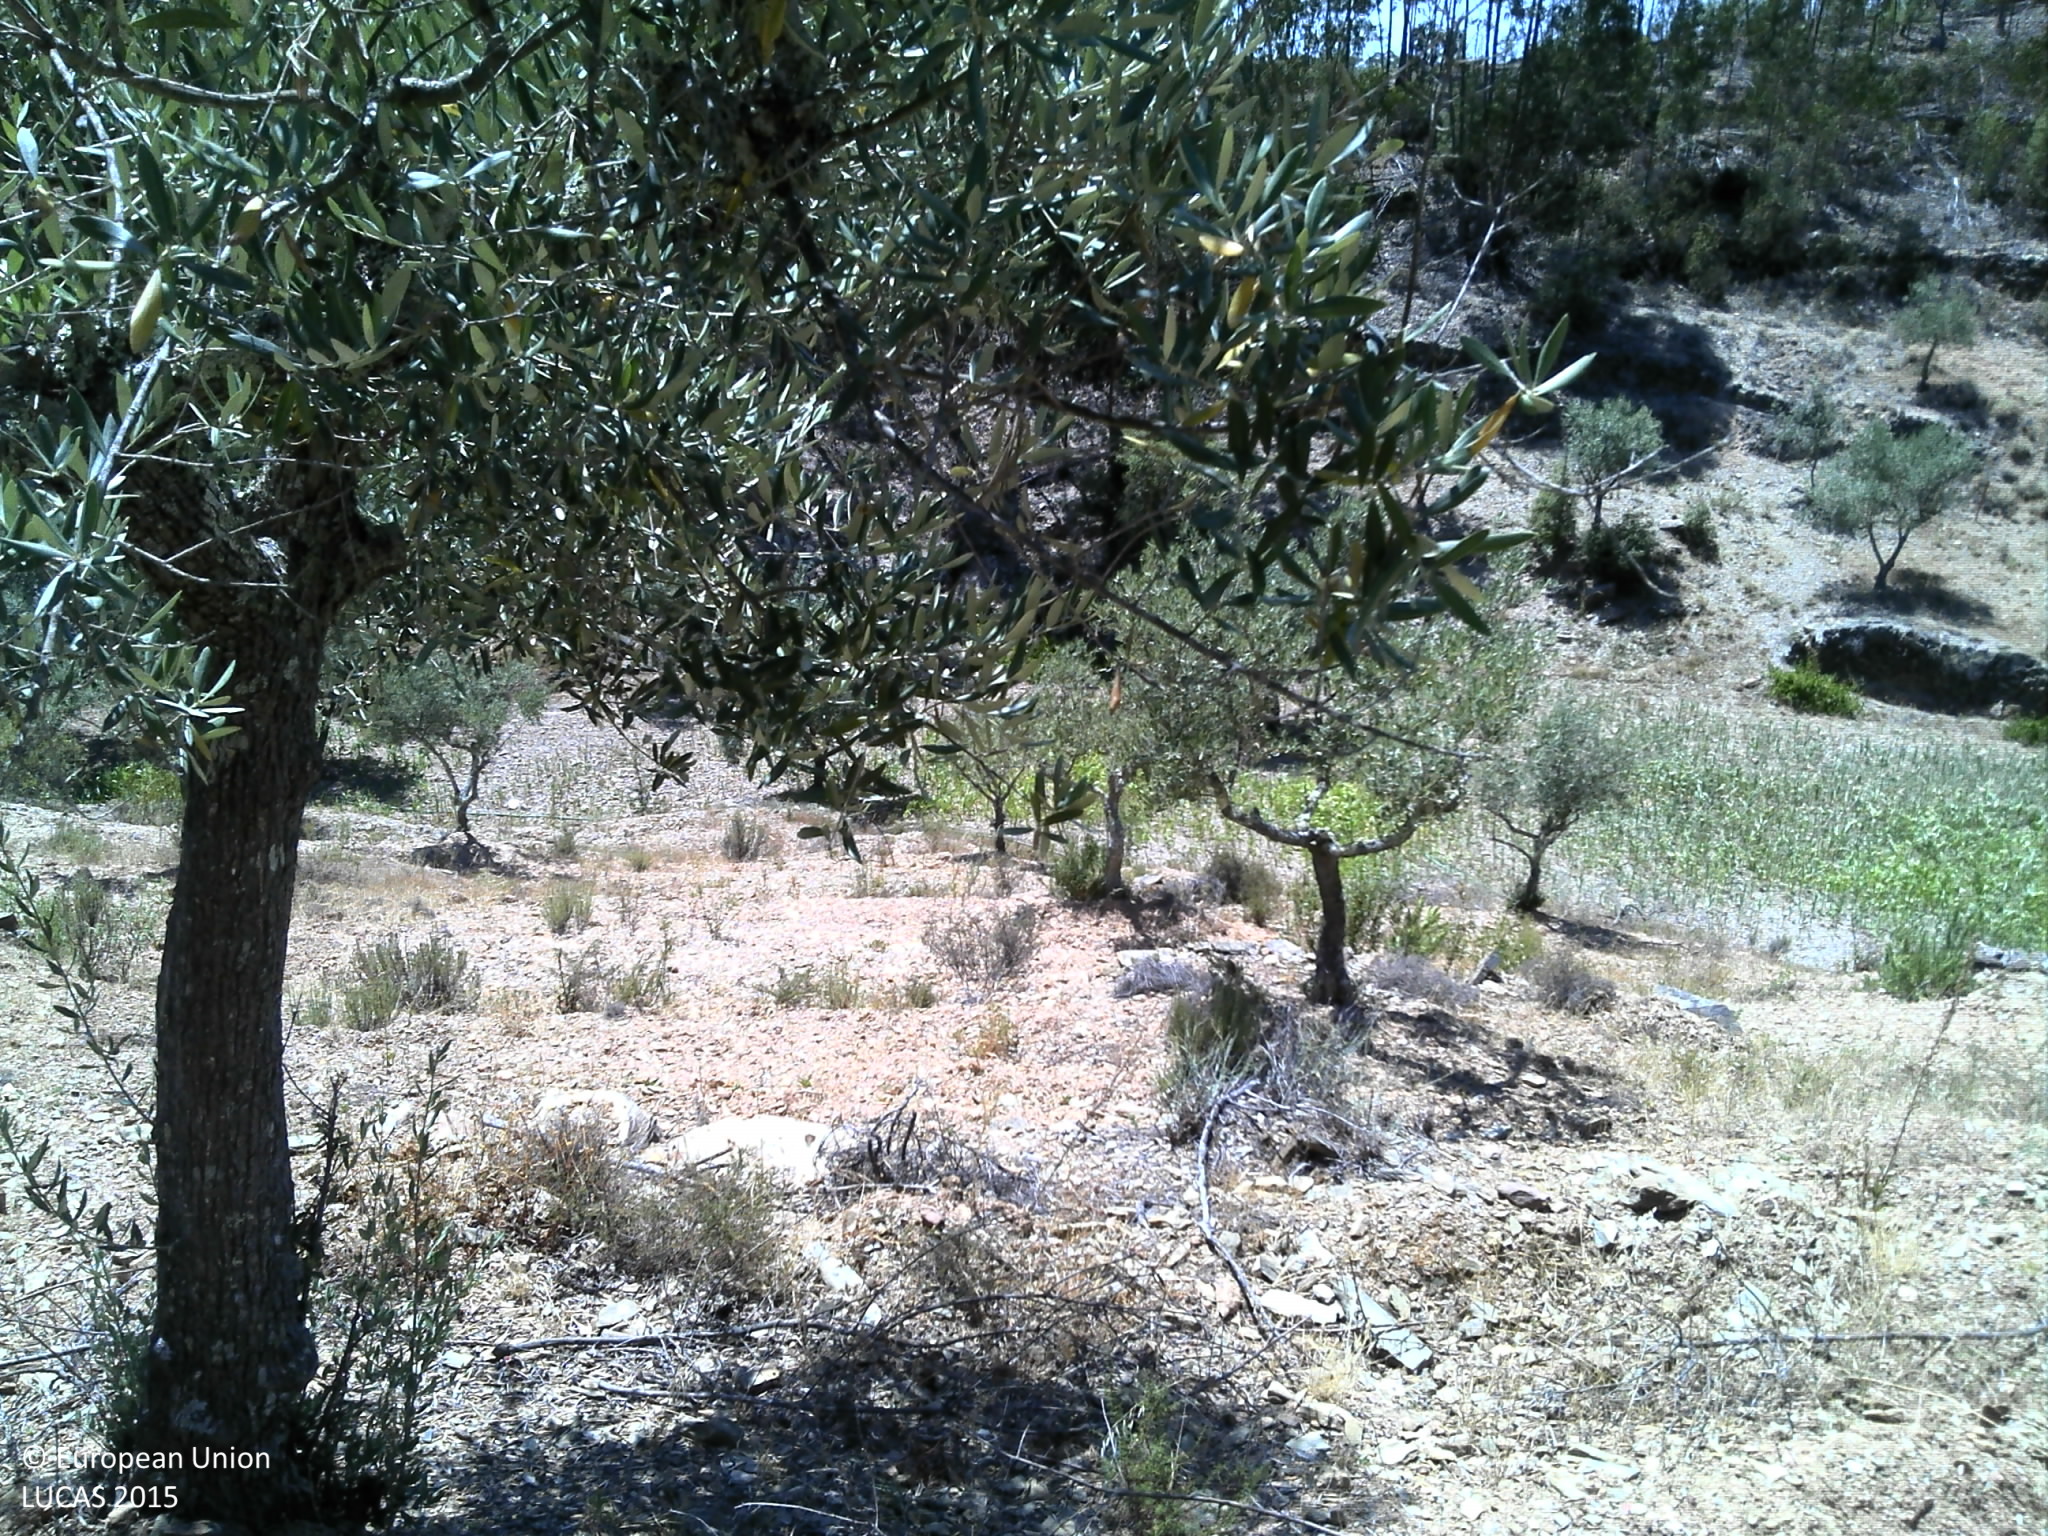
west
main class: Cropland
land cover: Olive groves
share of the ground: 10 - 25 %
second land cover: Shrubland without tree cover
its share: 10 - 25 %
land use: Agriculture (excluding fallow land and kitchen gardens)
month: July
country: PT
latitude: 39.6486
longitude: -7.7579
